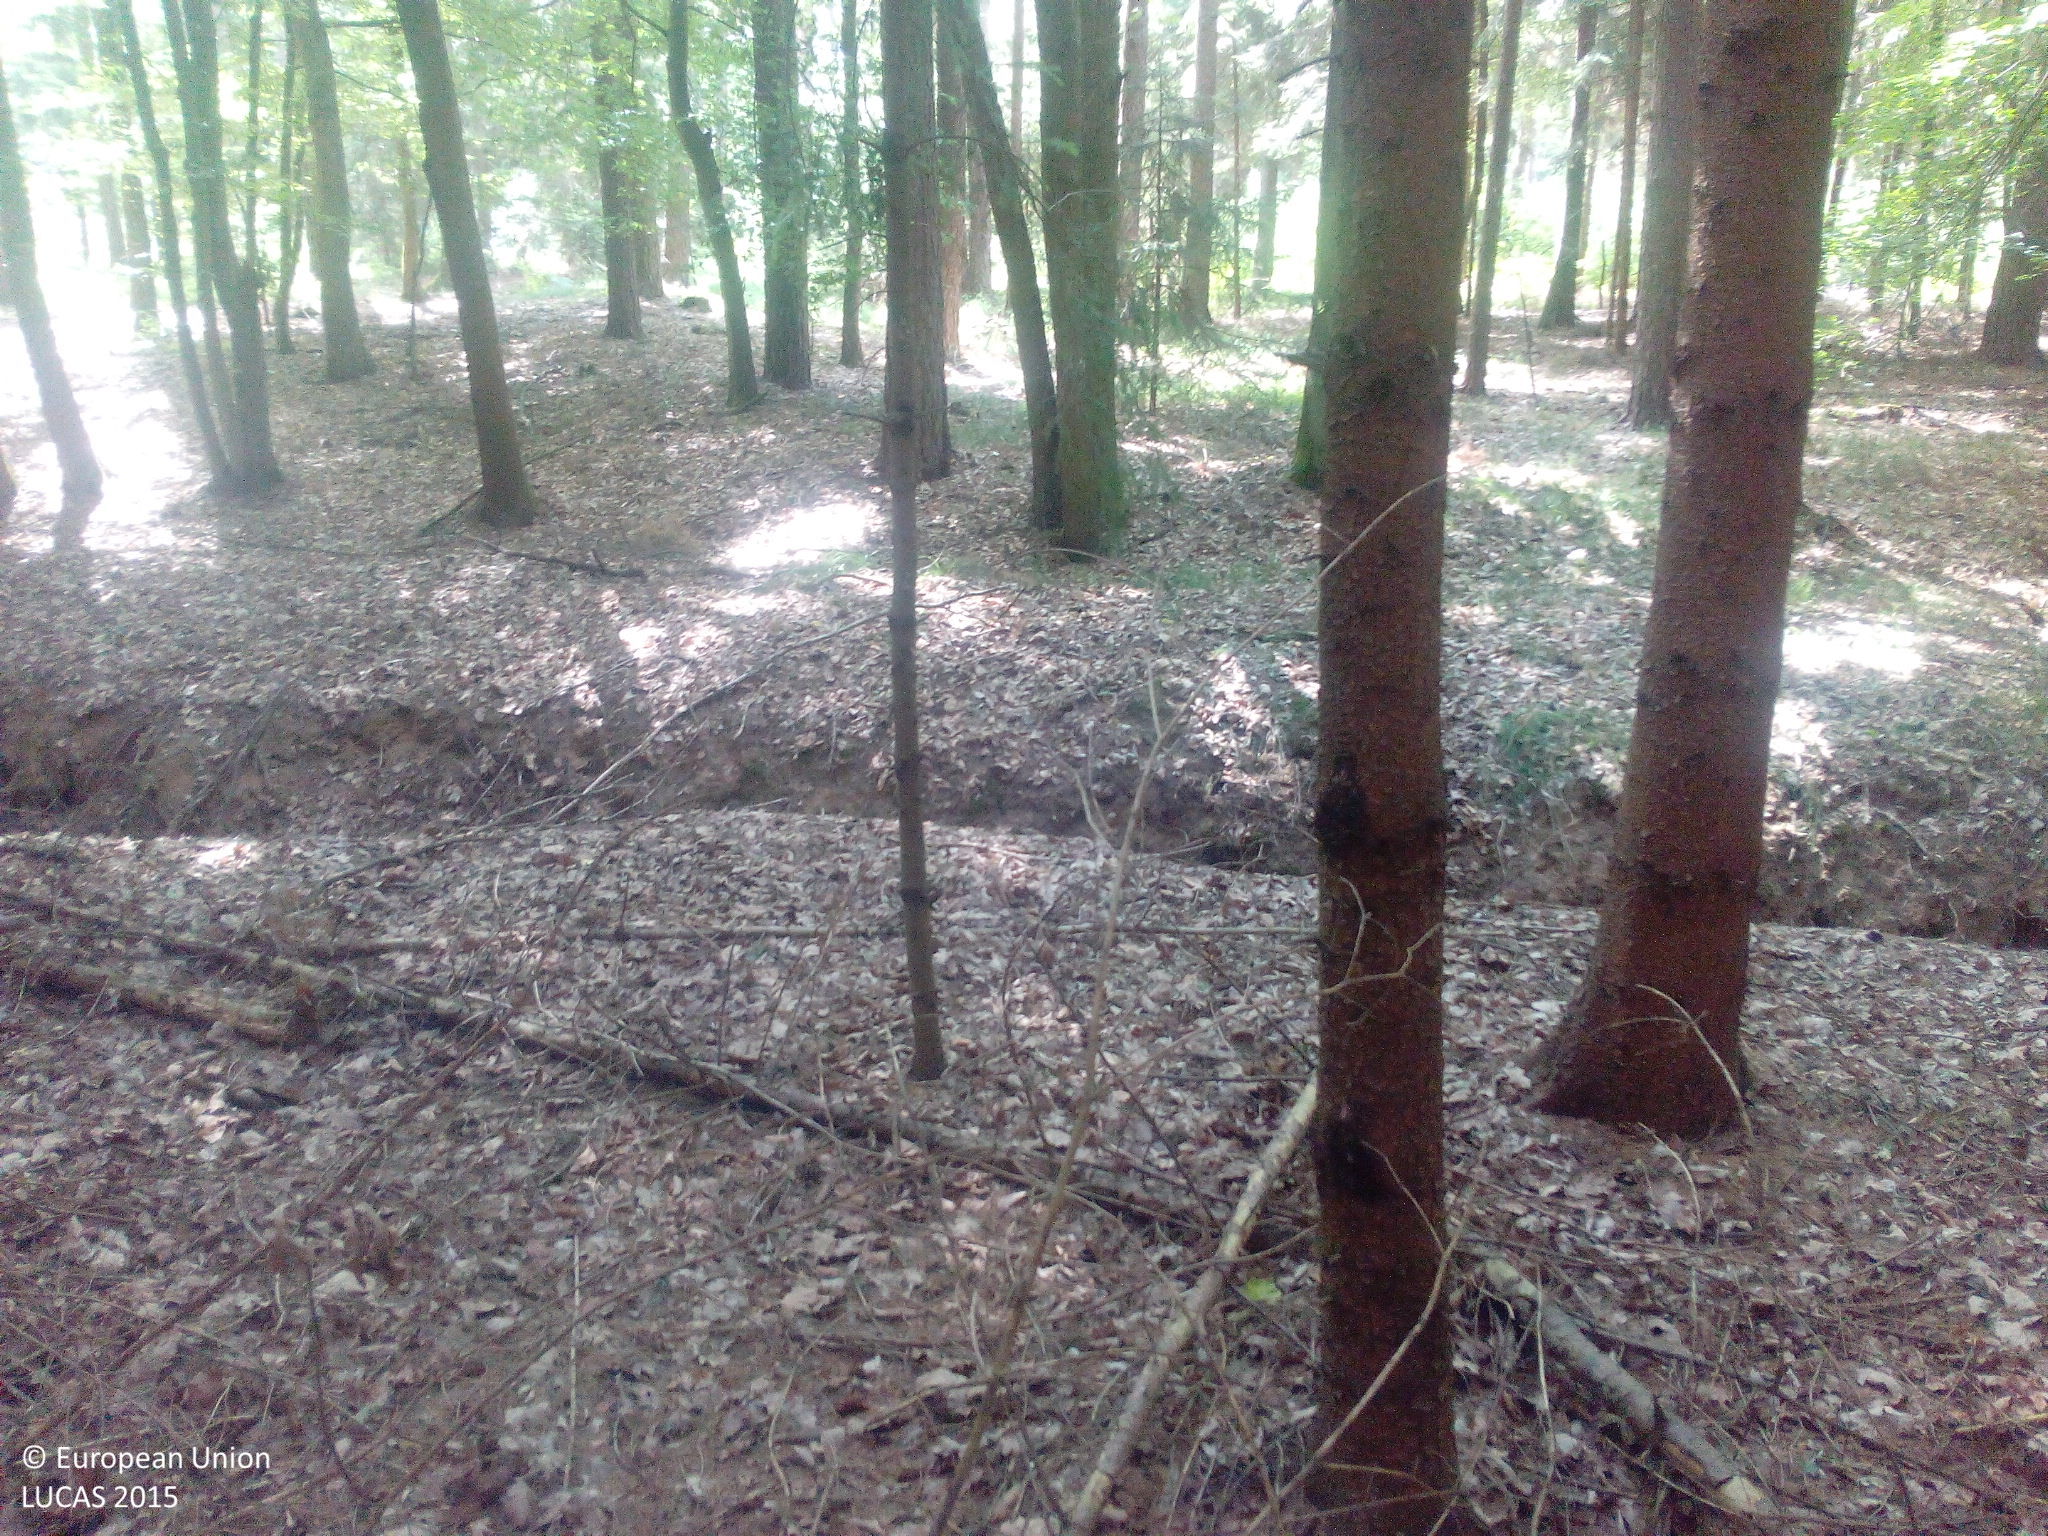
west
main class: Woodland
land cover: Spruce dominated coniferous woodland
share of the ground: > 75 %
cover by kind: coniferous forest trees 95 %, unconsolidated bare surface 5 %
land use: Forestry
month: July
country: DE
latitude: 49.7670
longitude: 10.9022
